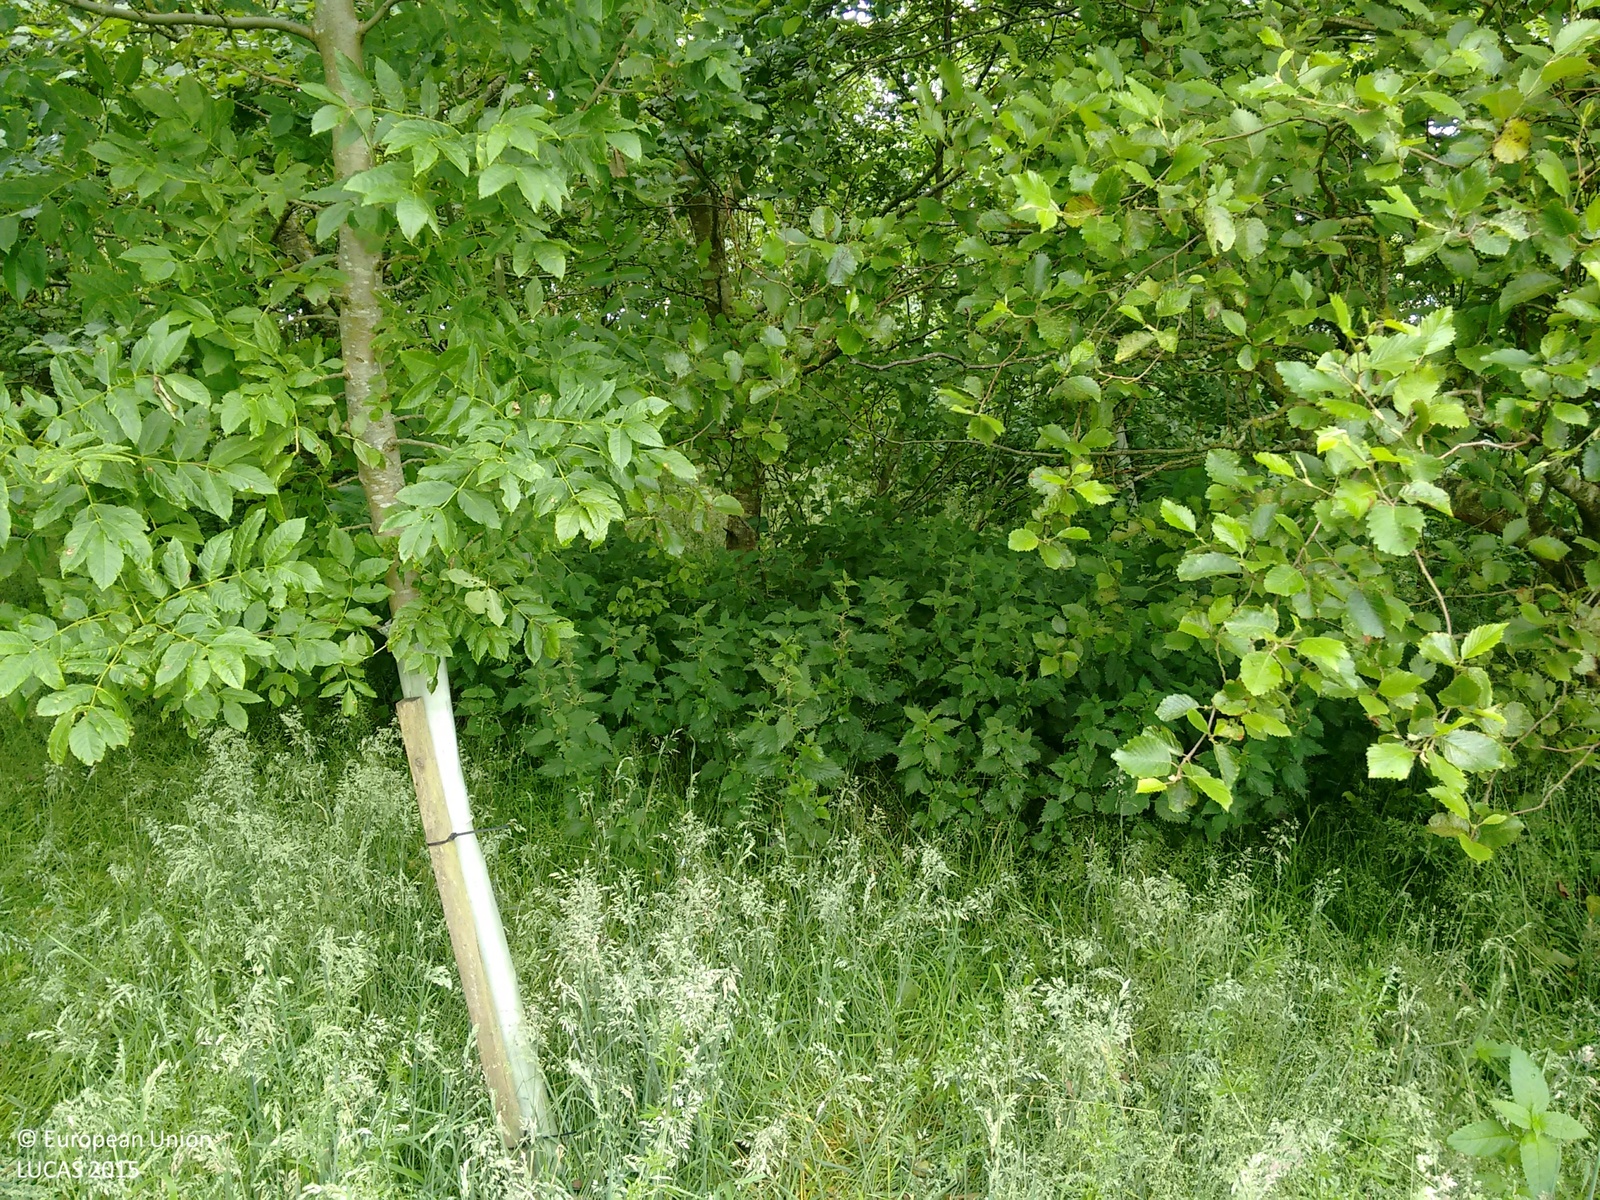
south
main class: Woodland
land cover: Broadleaved woodland
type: mesophytic deciduous forest
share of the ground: > 75 %
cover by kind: broadleaved forest trees 90 %, herbaceous plants 10 %
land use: Forestry
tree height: > 5 m
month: July
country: GB
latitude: 57.4258
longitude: -1.9857
